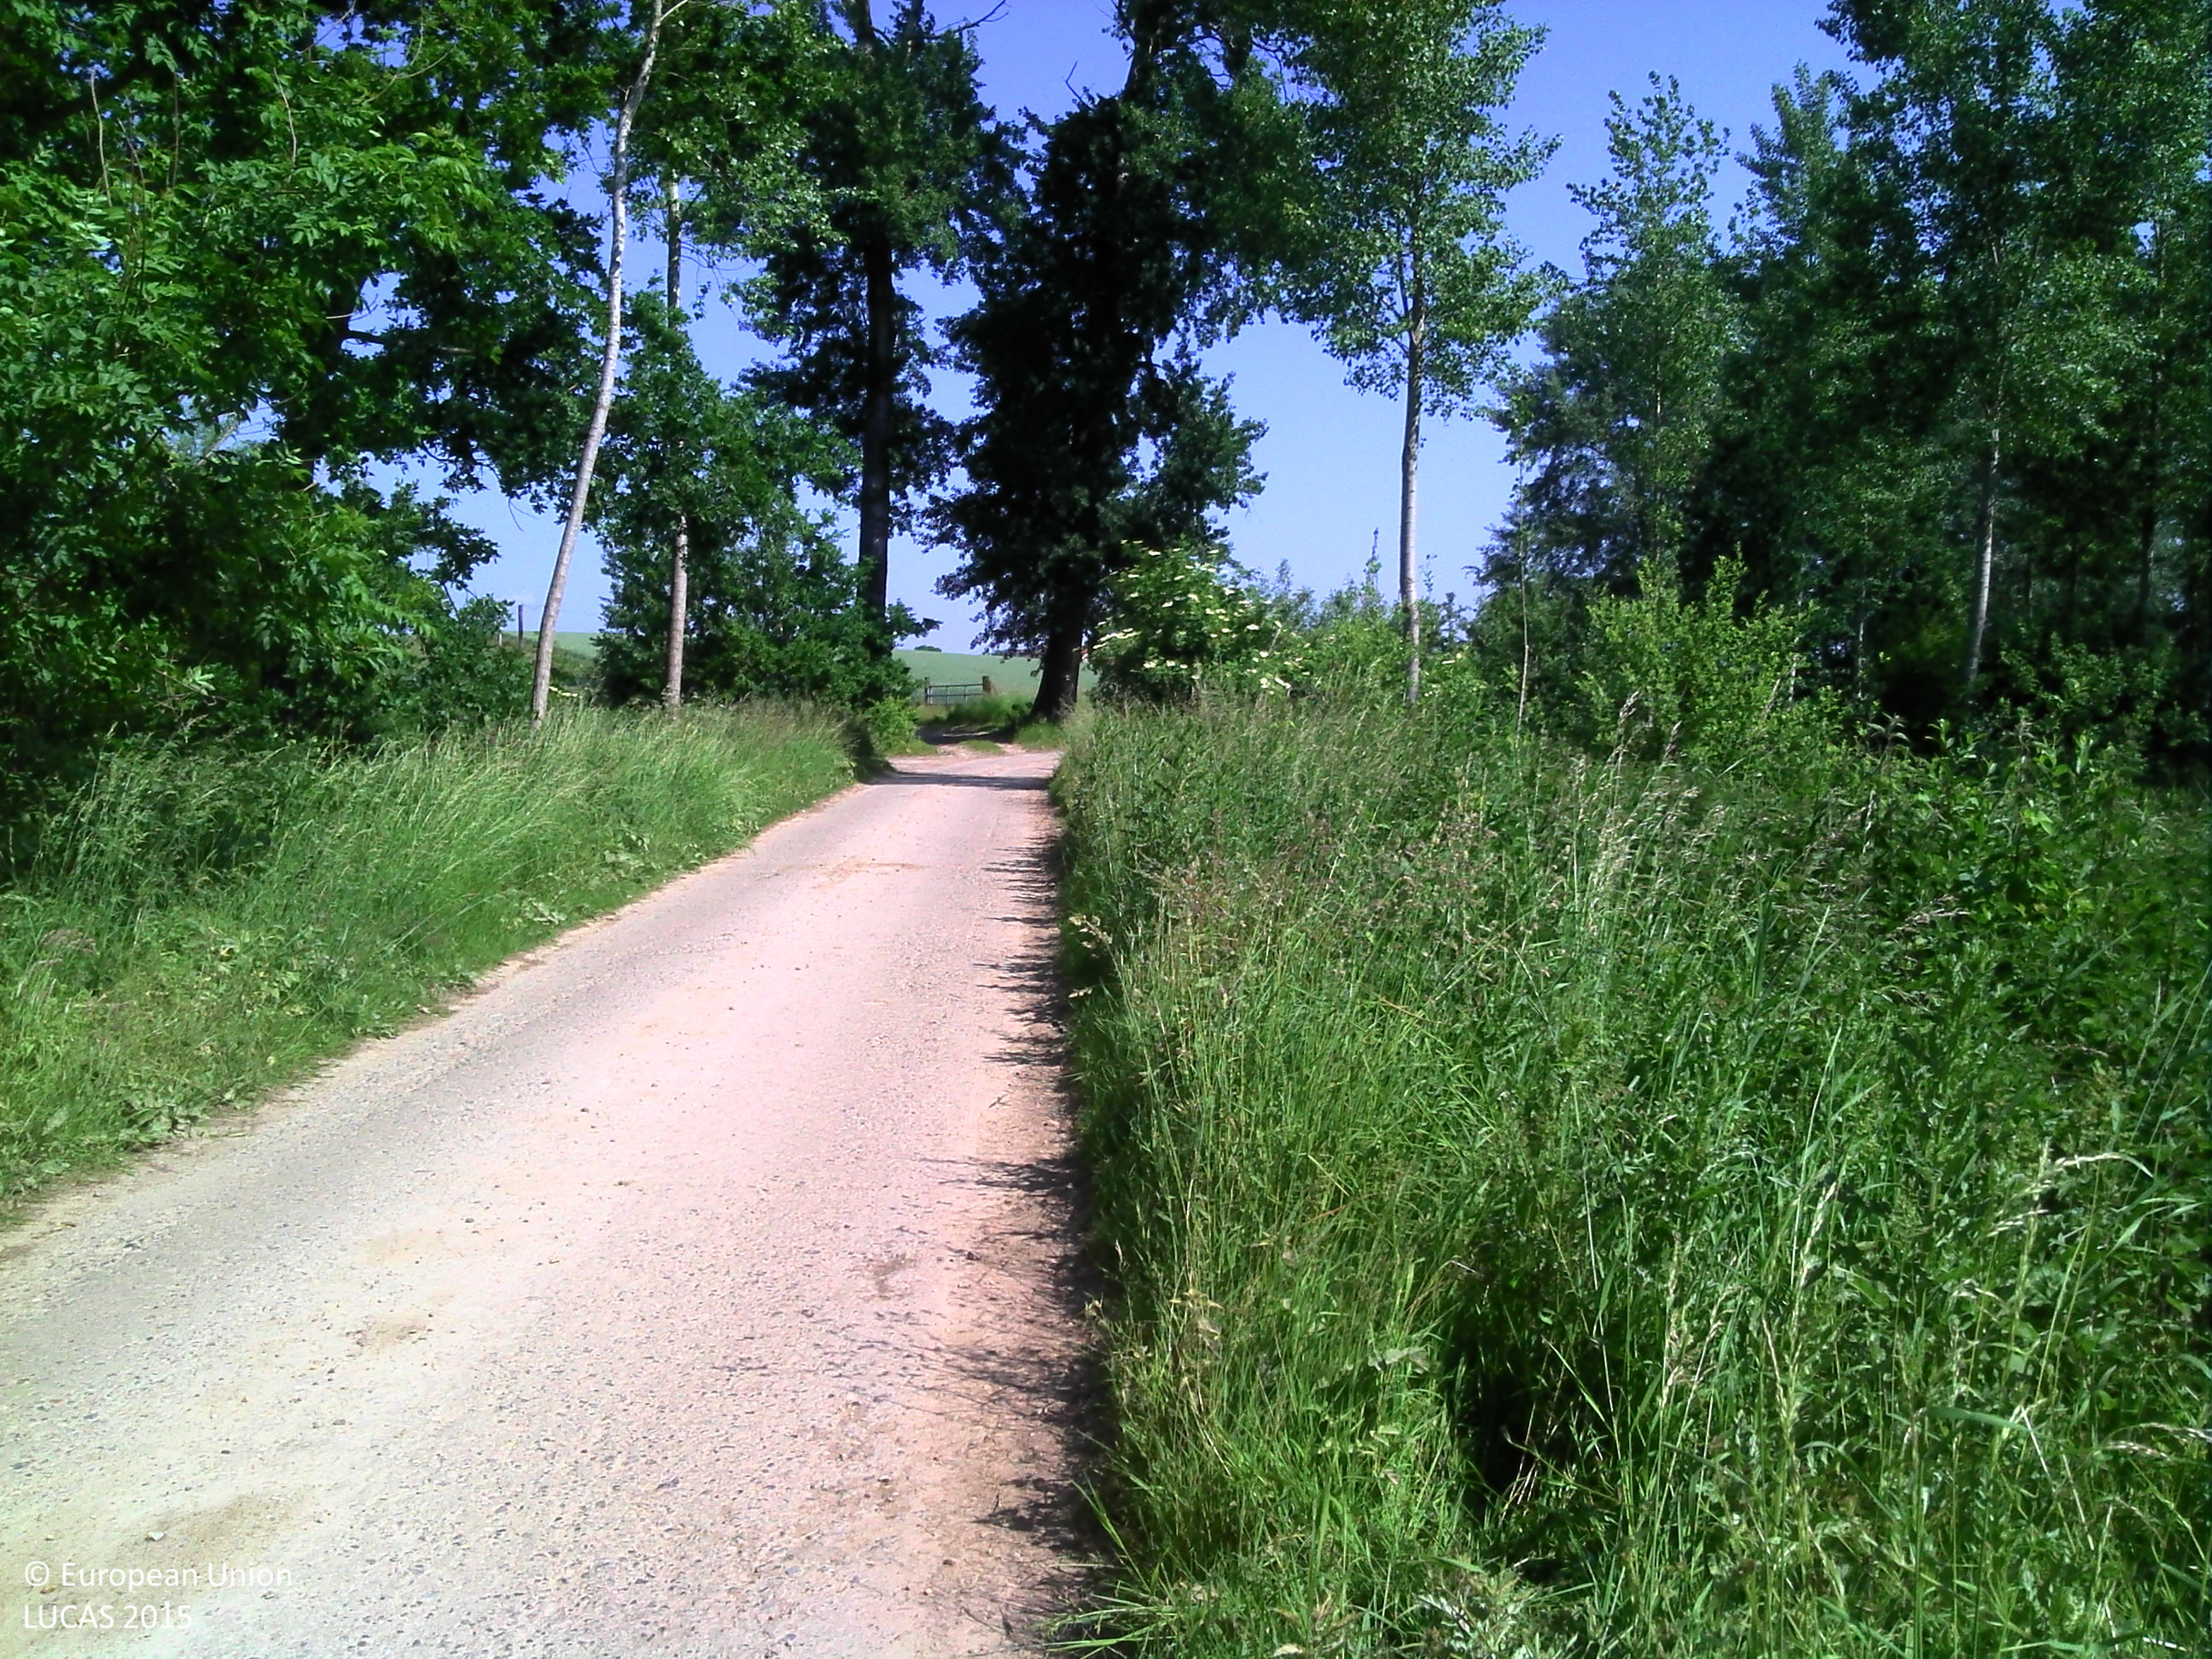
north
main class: Grassland
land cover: Spontaneously vegetated surfaces
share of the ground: > 75 %
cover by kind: herbaceous plants 100 %
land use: Semi-natural and natural areas not in use
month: June
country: BE
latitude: 50.8158
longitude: 5.4988
